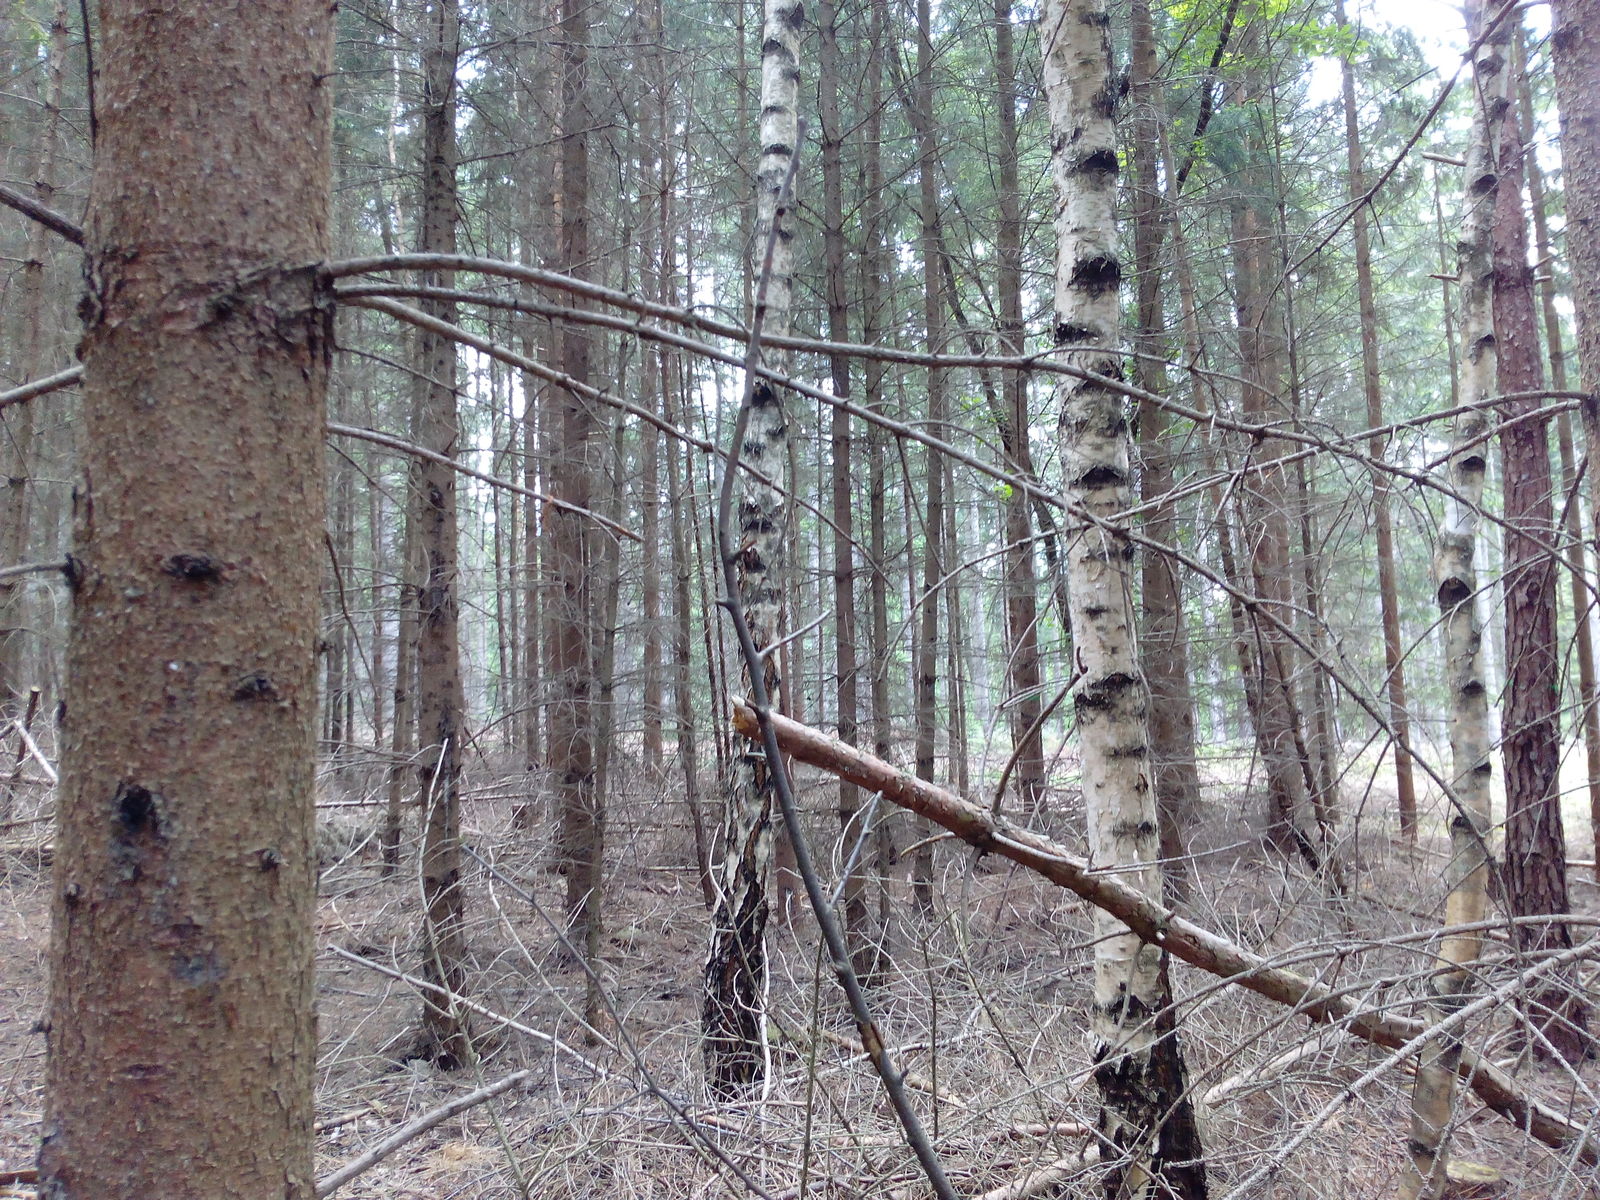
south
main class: Woodland
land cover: Spruce dominated coniferous woodland
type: hemiboreal forest and nemoral coniferous forest and mixed broadleaved-coniferous forest
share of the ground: > 75 %
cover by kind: coniferous forest trees 95 %, broadleaved forest trees 5 %
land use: Forestry
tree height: > 5 m
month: June
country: DE
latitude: 50.7566
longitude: 10.8361
